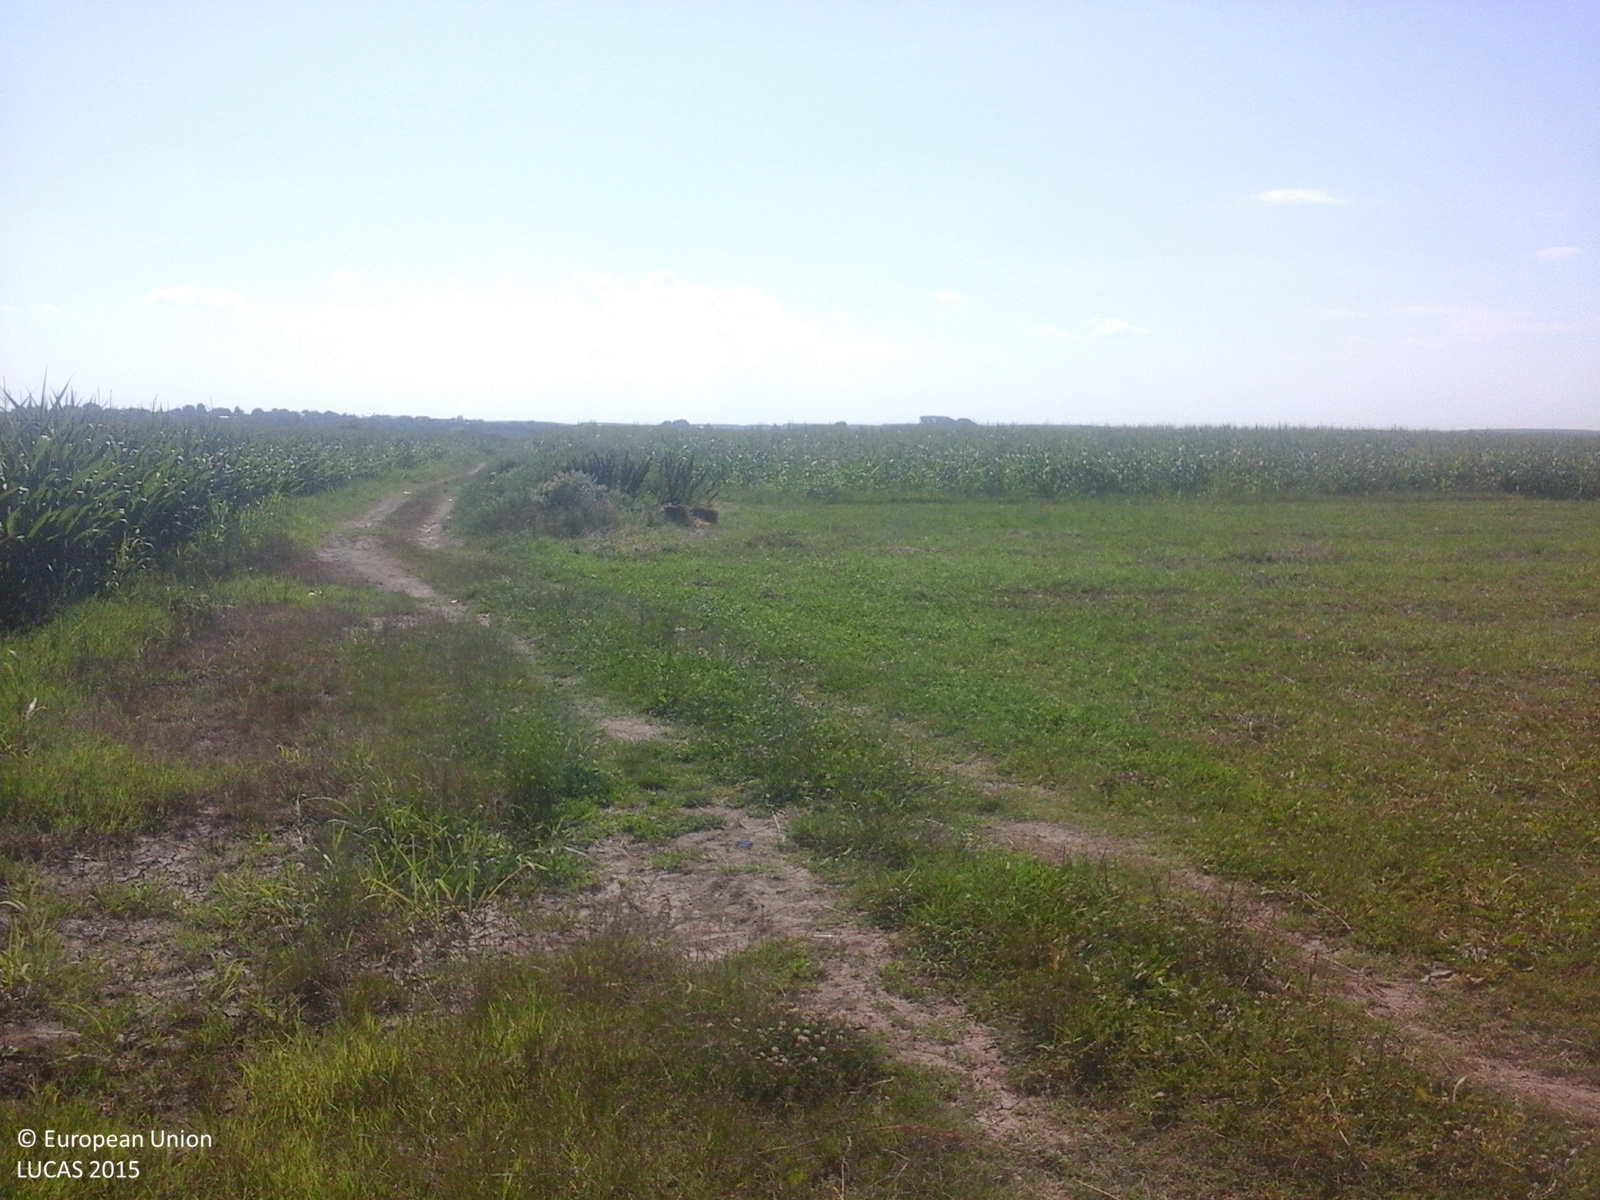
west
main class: Cropland
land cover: Maize
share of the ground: > 75 %
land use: Agriculture (excluding fallow land and kitchen gardens)
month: July
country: RO
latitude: 44.4158
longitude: 24.2957
